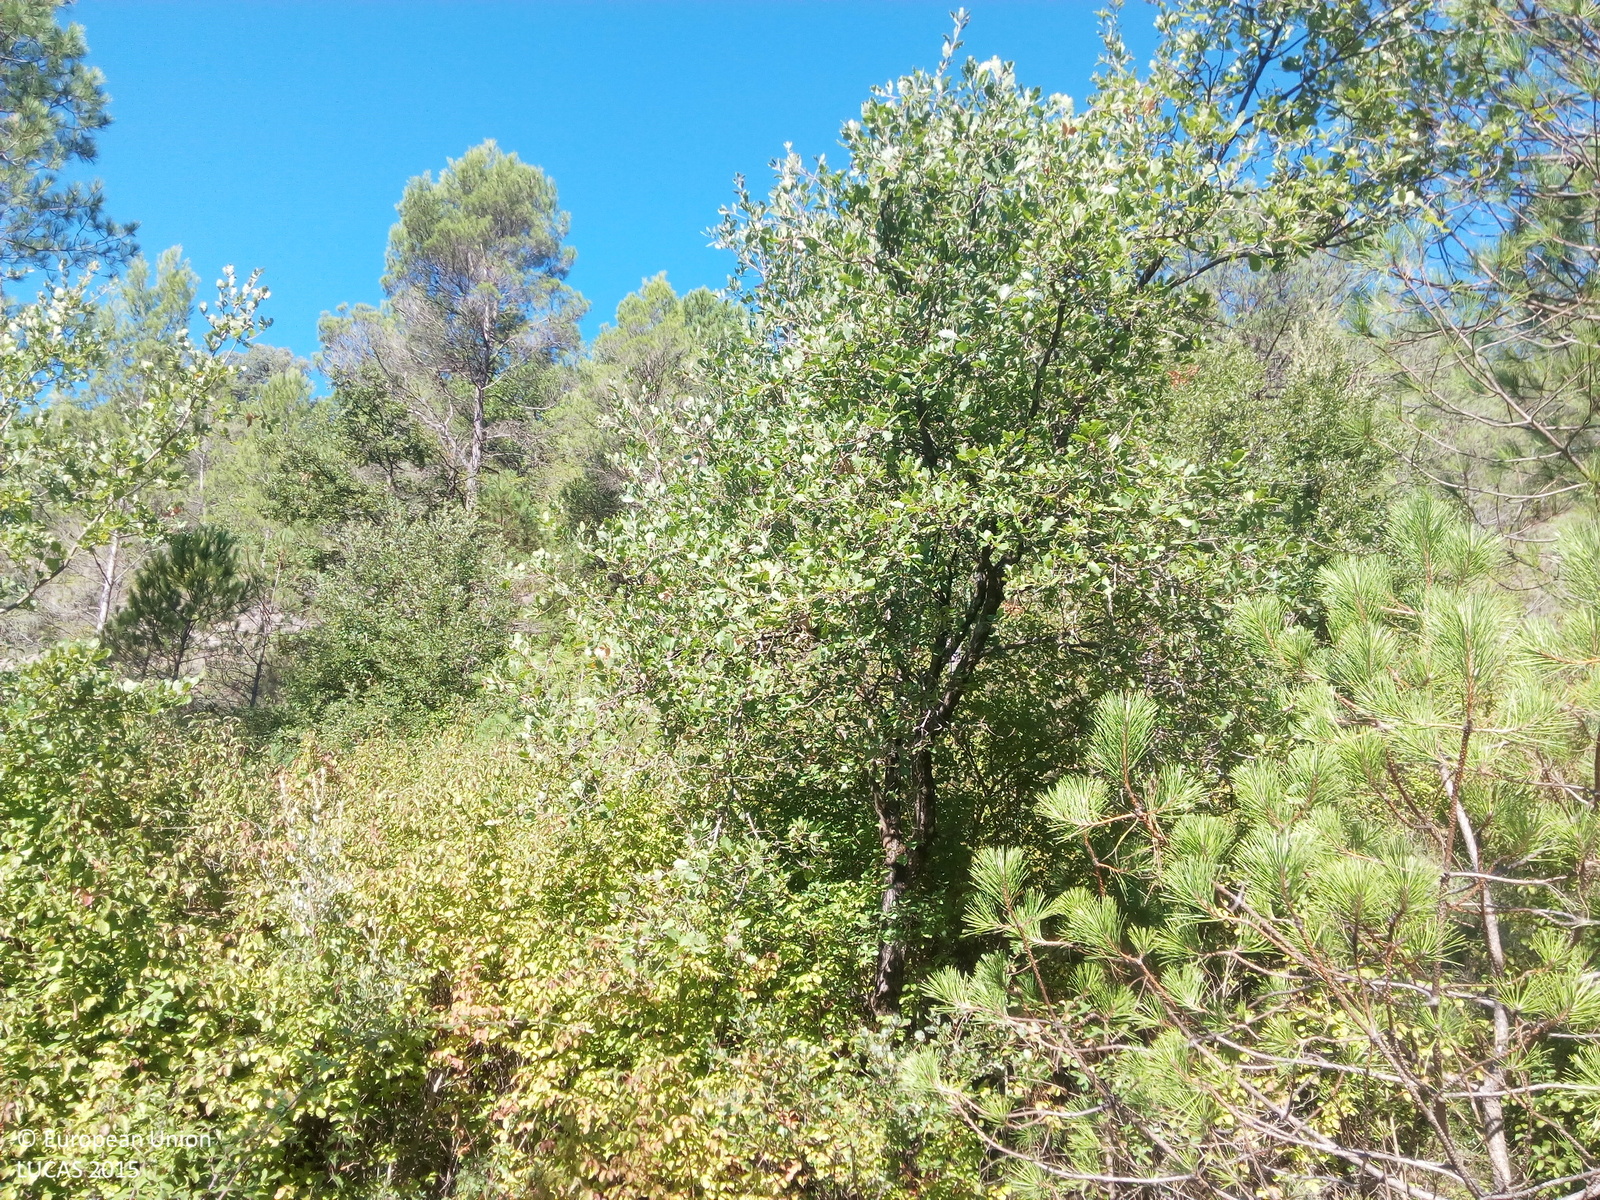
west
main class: Woodland
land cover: Pine dominated mixed woodland
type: alpine coniferous forest
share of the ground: > 75 %
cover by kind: coniferous forest trees 40 %, broadleaved forest trees 30 %, shrubs 20 %, consolidated bare surface 10 %
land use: Semi-natural and natural areas not in use
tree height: > 5 m
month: August
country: ES
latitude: 42.4161
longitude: 0.2211
